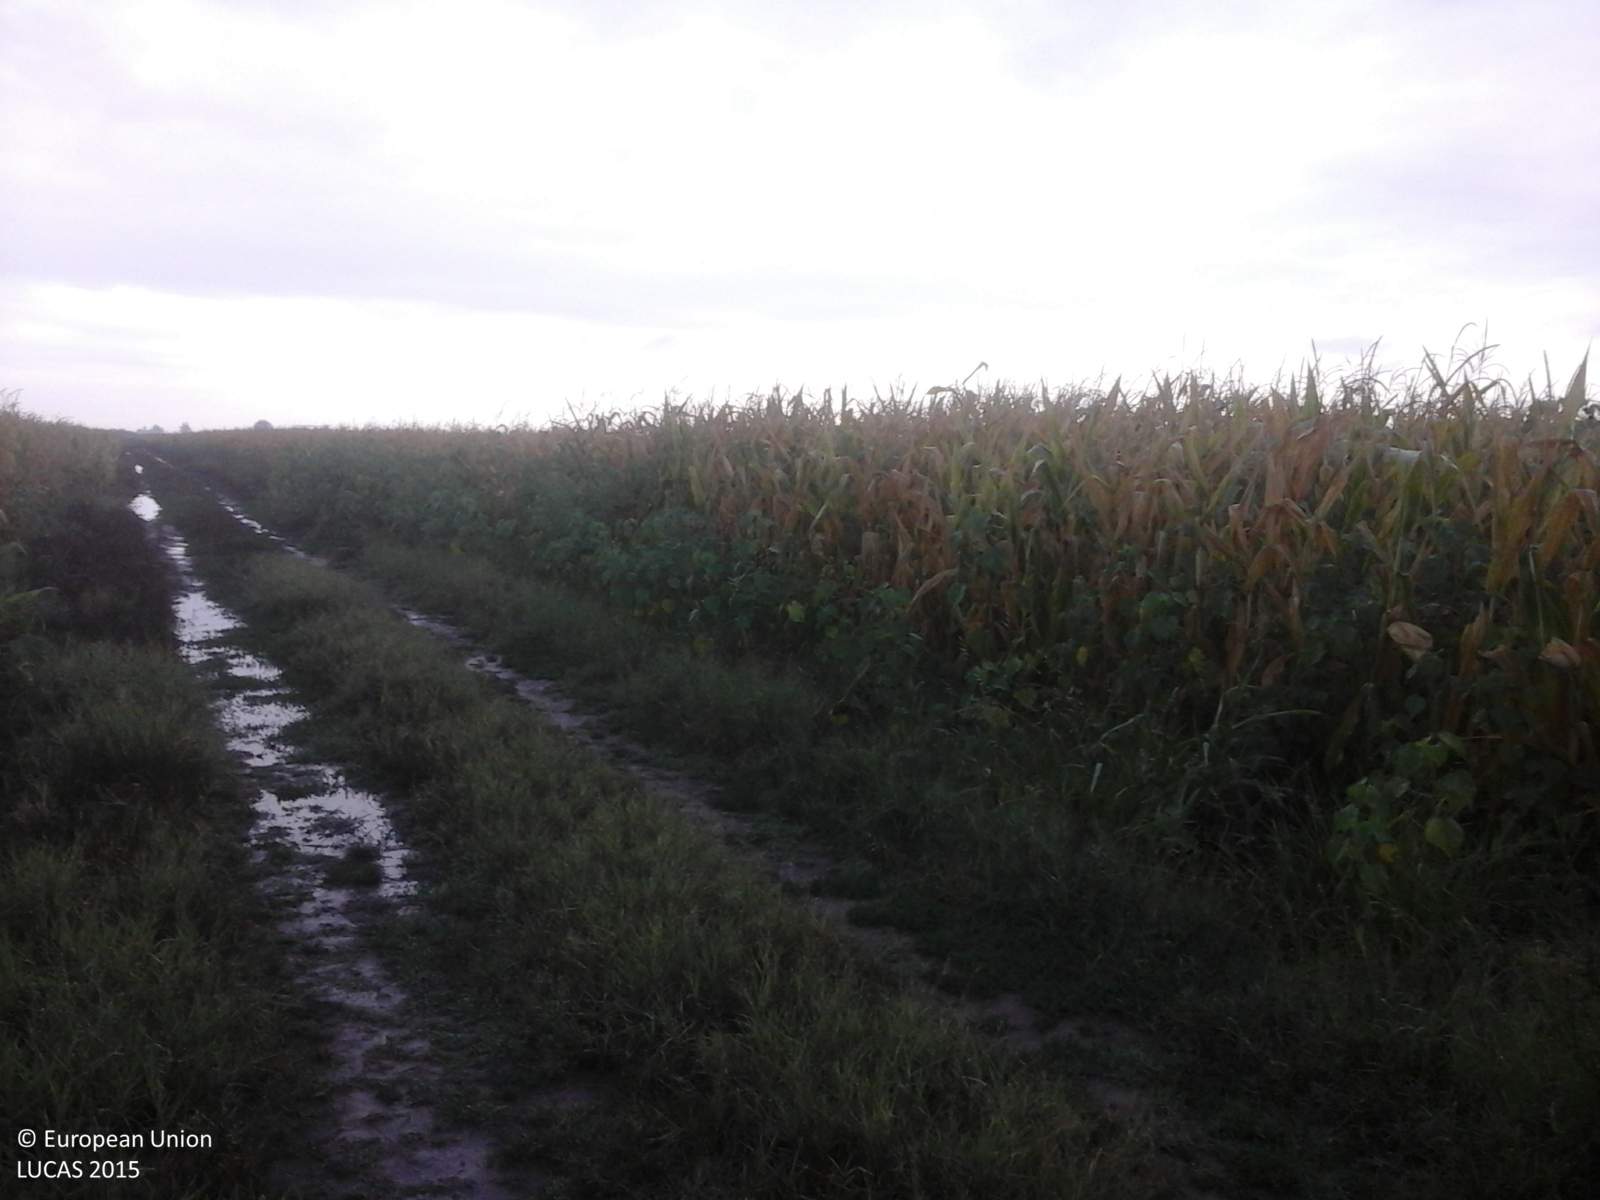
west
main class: Cropland
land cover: Maize
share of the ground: > 75 %
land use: Agriculture (excluding fallow land and kitchen gardens)
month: August
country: RO
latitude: 45.6264
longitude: 21.0976
